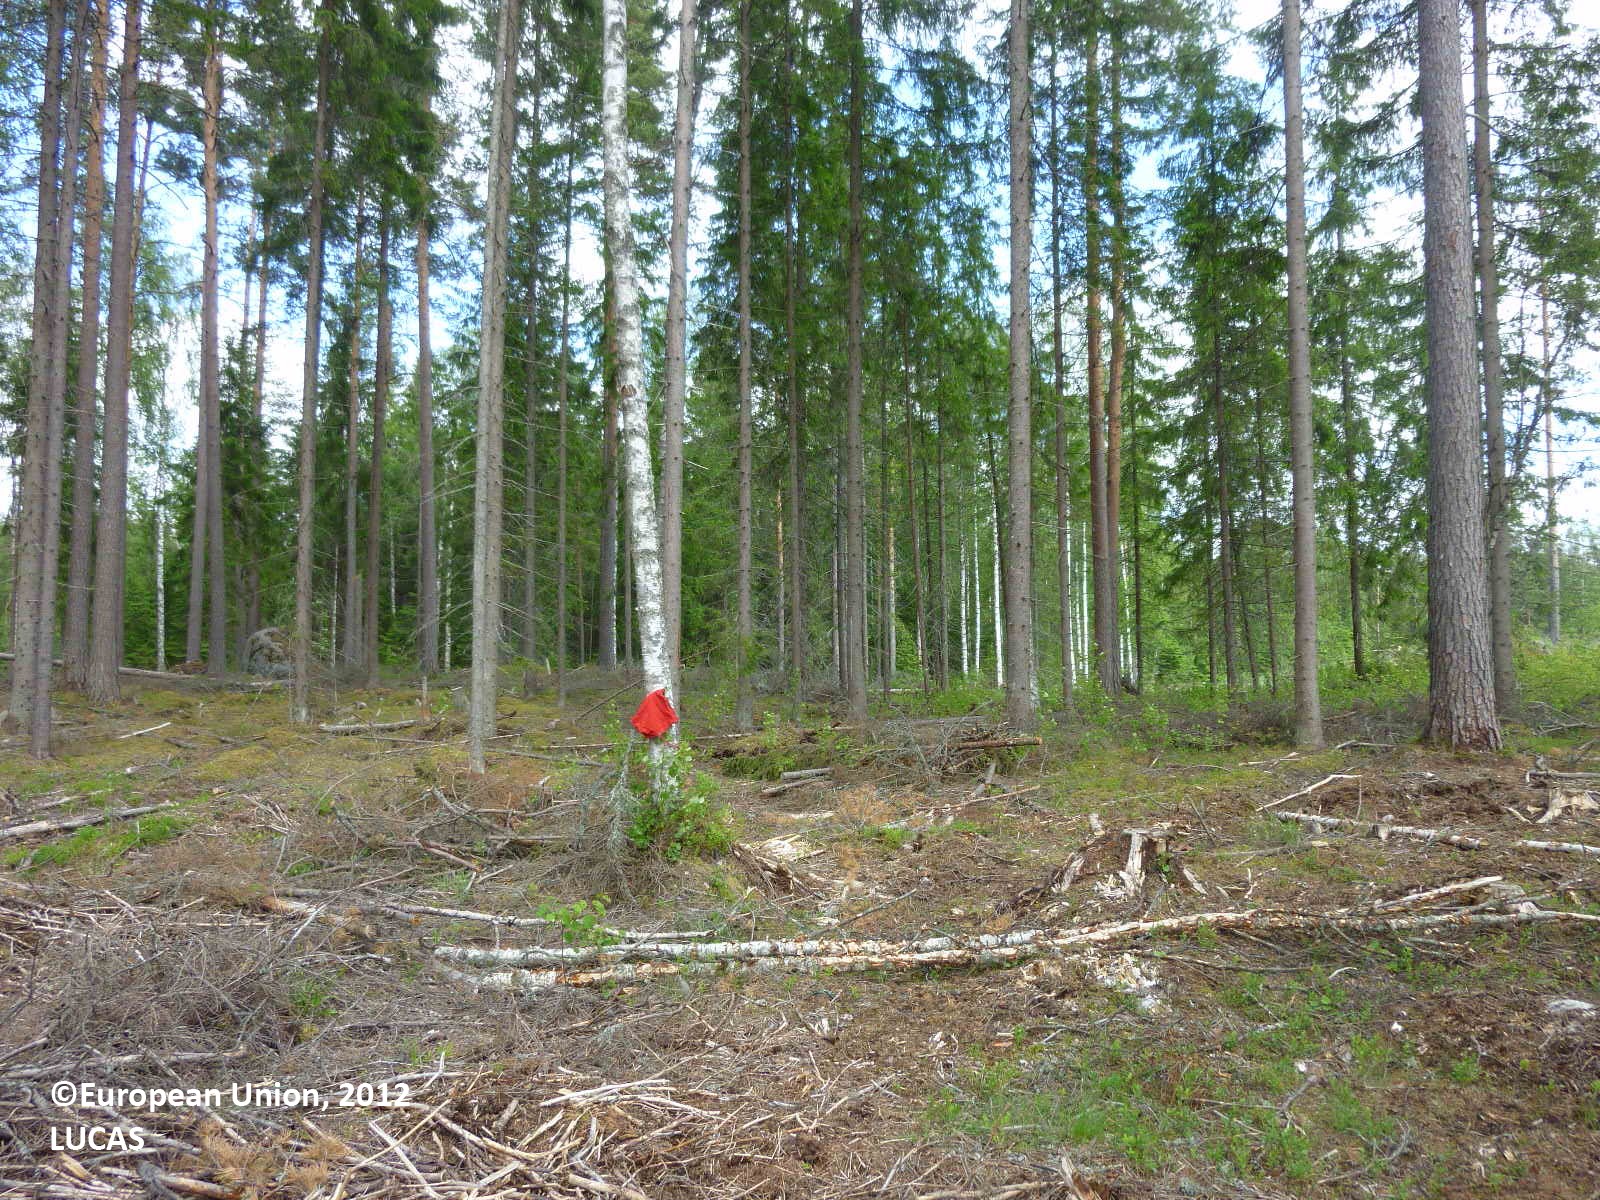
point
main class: Woodland
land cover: Spruce dominated mixed woodland
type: boreal forest
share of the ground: 50 - 75 %
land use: Forestry
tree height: > 5 m
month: June
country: FI
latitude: 61.7395
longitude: 22.3082
